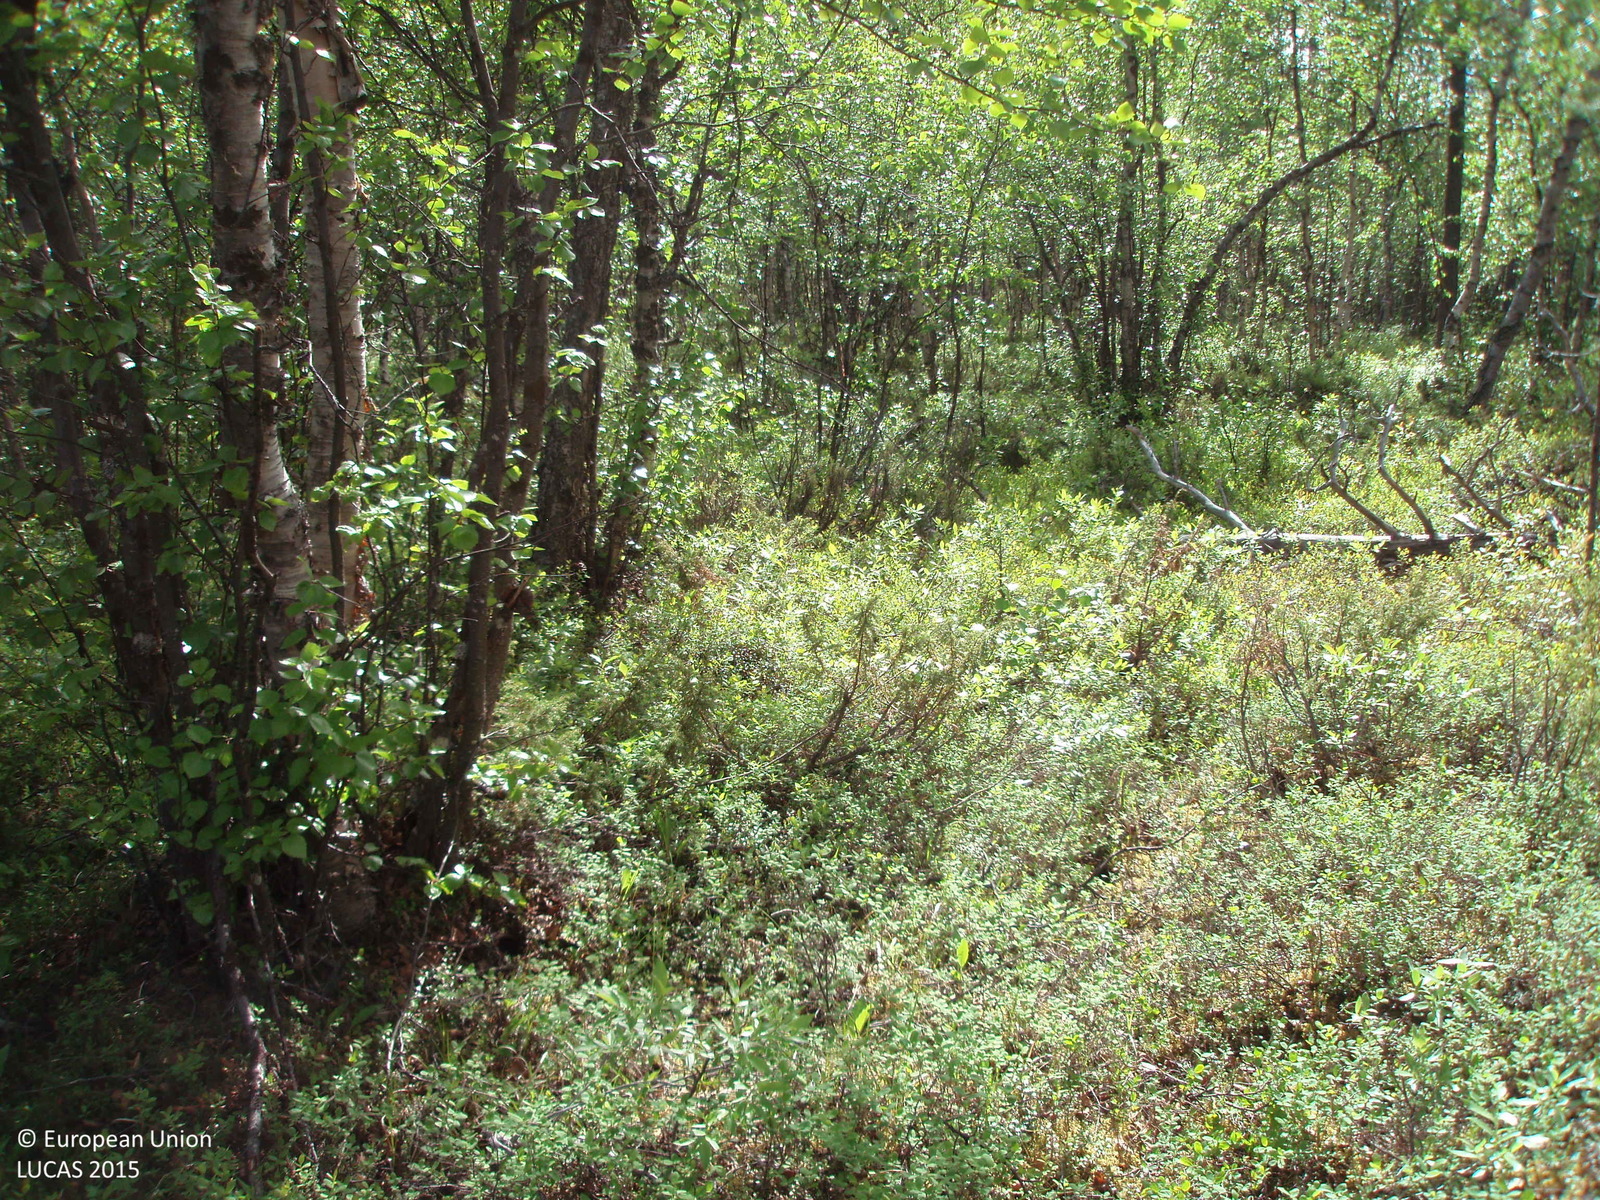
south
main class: Woodland
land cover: Pine dominated mixed woodland
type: boreal forest
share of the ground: > 75 %
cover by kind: coniferous forest trees 40 %, broadleaved forest trees 35 %, shrubs 25 %
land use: Forestry
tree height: > 5 m
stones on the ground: > 50 %
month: July
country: FI
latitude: 68.9083
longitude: 25.7938
